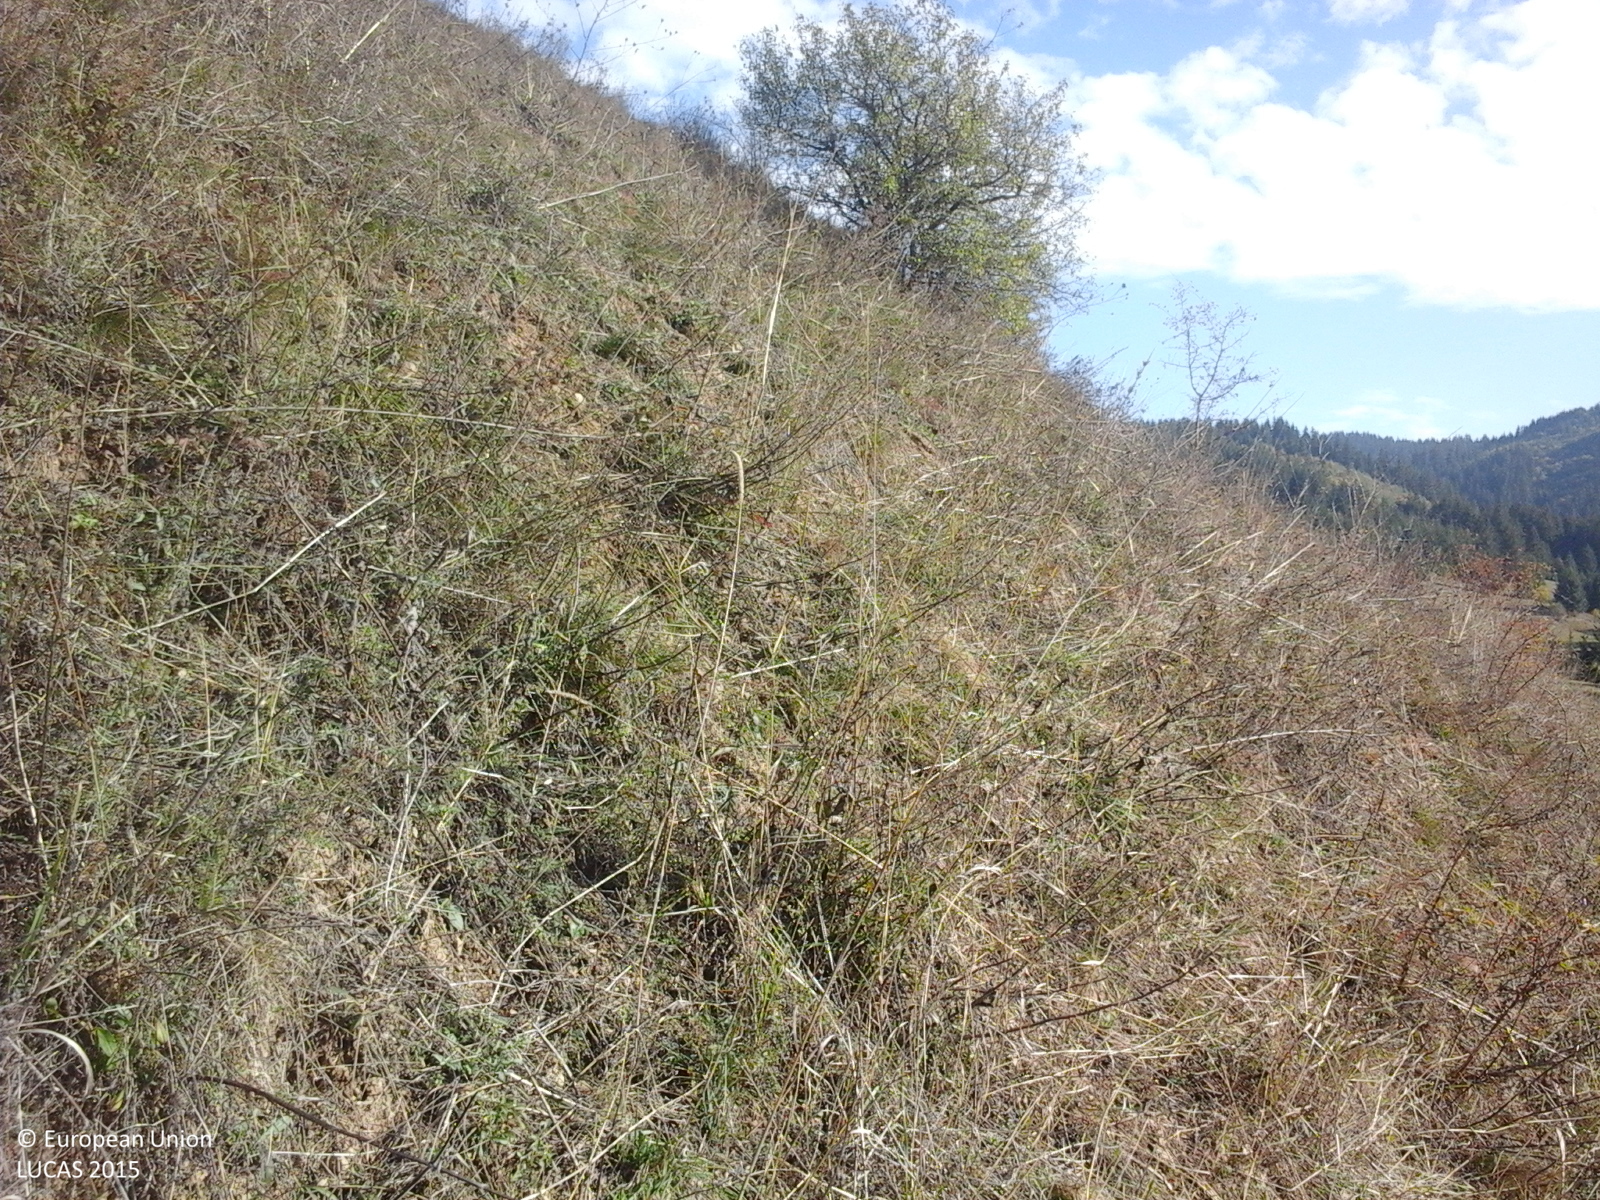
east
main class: Grassland
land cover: Spontaneously vegetated surfaces
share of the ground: > 75 %
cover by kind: herbaceous plants 100 %
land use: Fallow land
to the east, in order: Spontaneously vegetated surfaces; Lines of trees; Spontaneously vegetated surfaces; Fences; Abandoned hedges; Grass margins; Rocks and stones; Ditches and canals; Abandoned hedges; Tracks; Ditches and canals; Grass margins; Fences; Grassland without tree/shrub cover; Fences; Grassland without tree/shrub cover
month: October
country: RO
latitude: 46.3324
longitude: 25.9806
